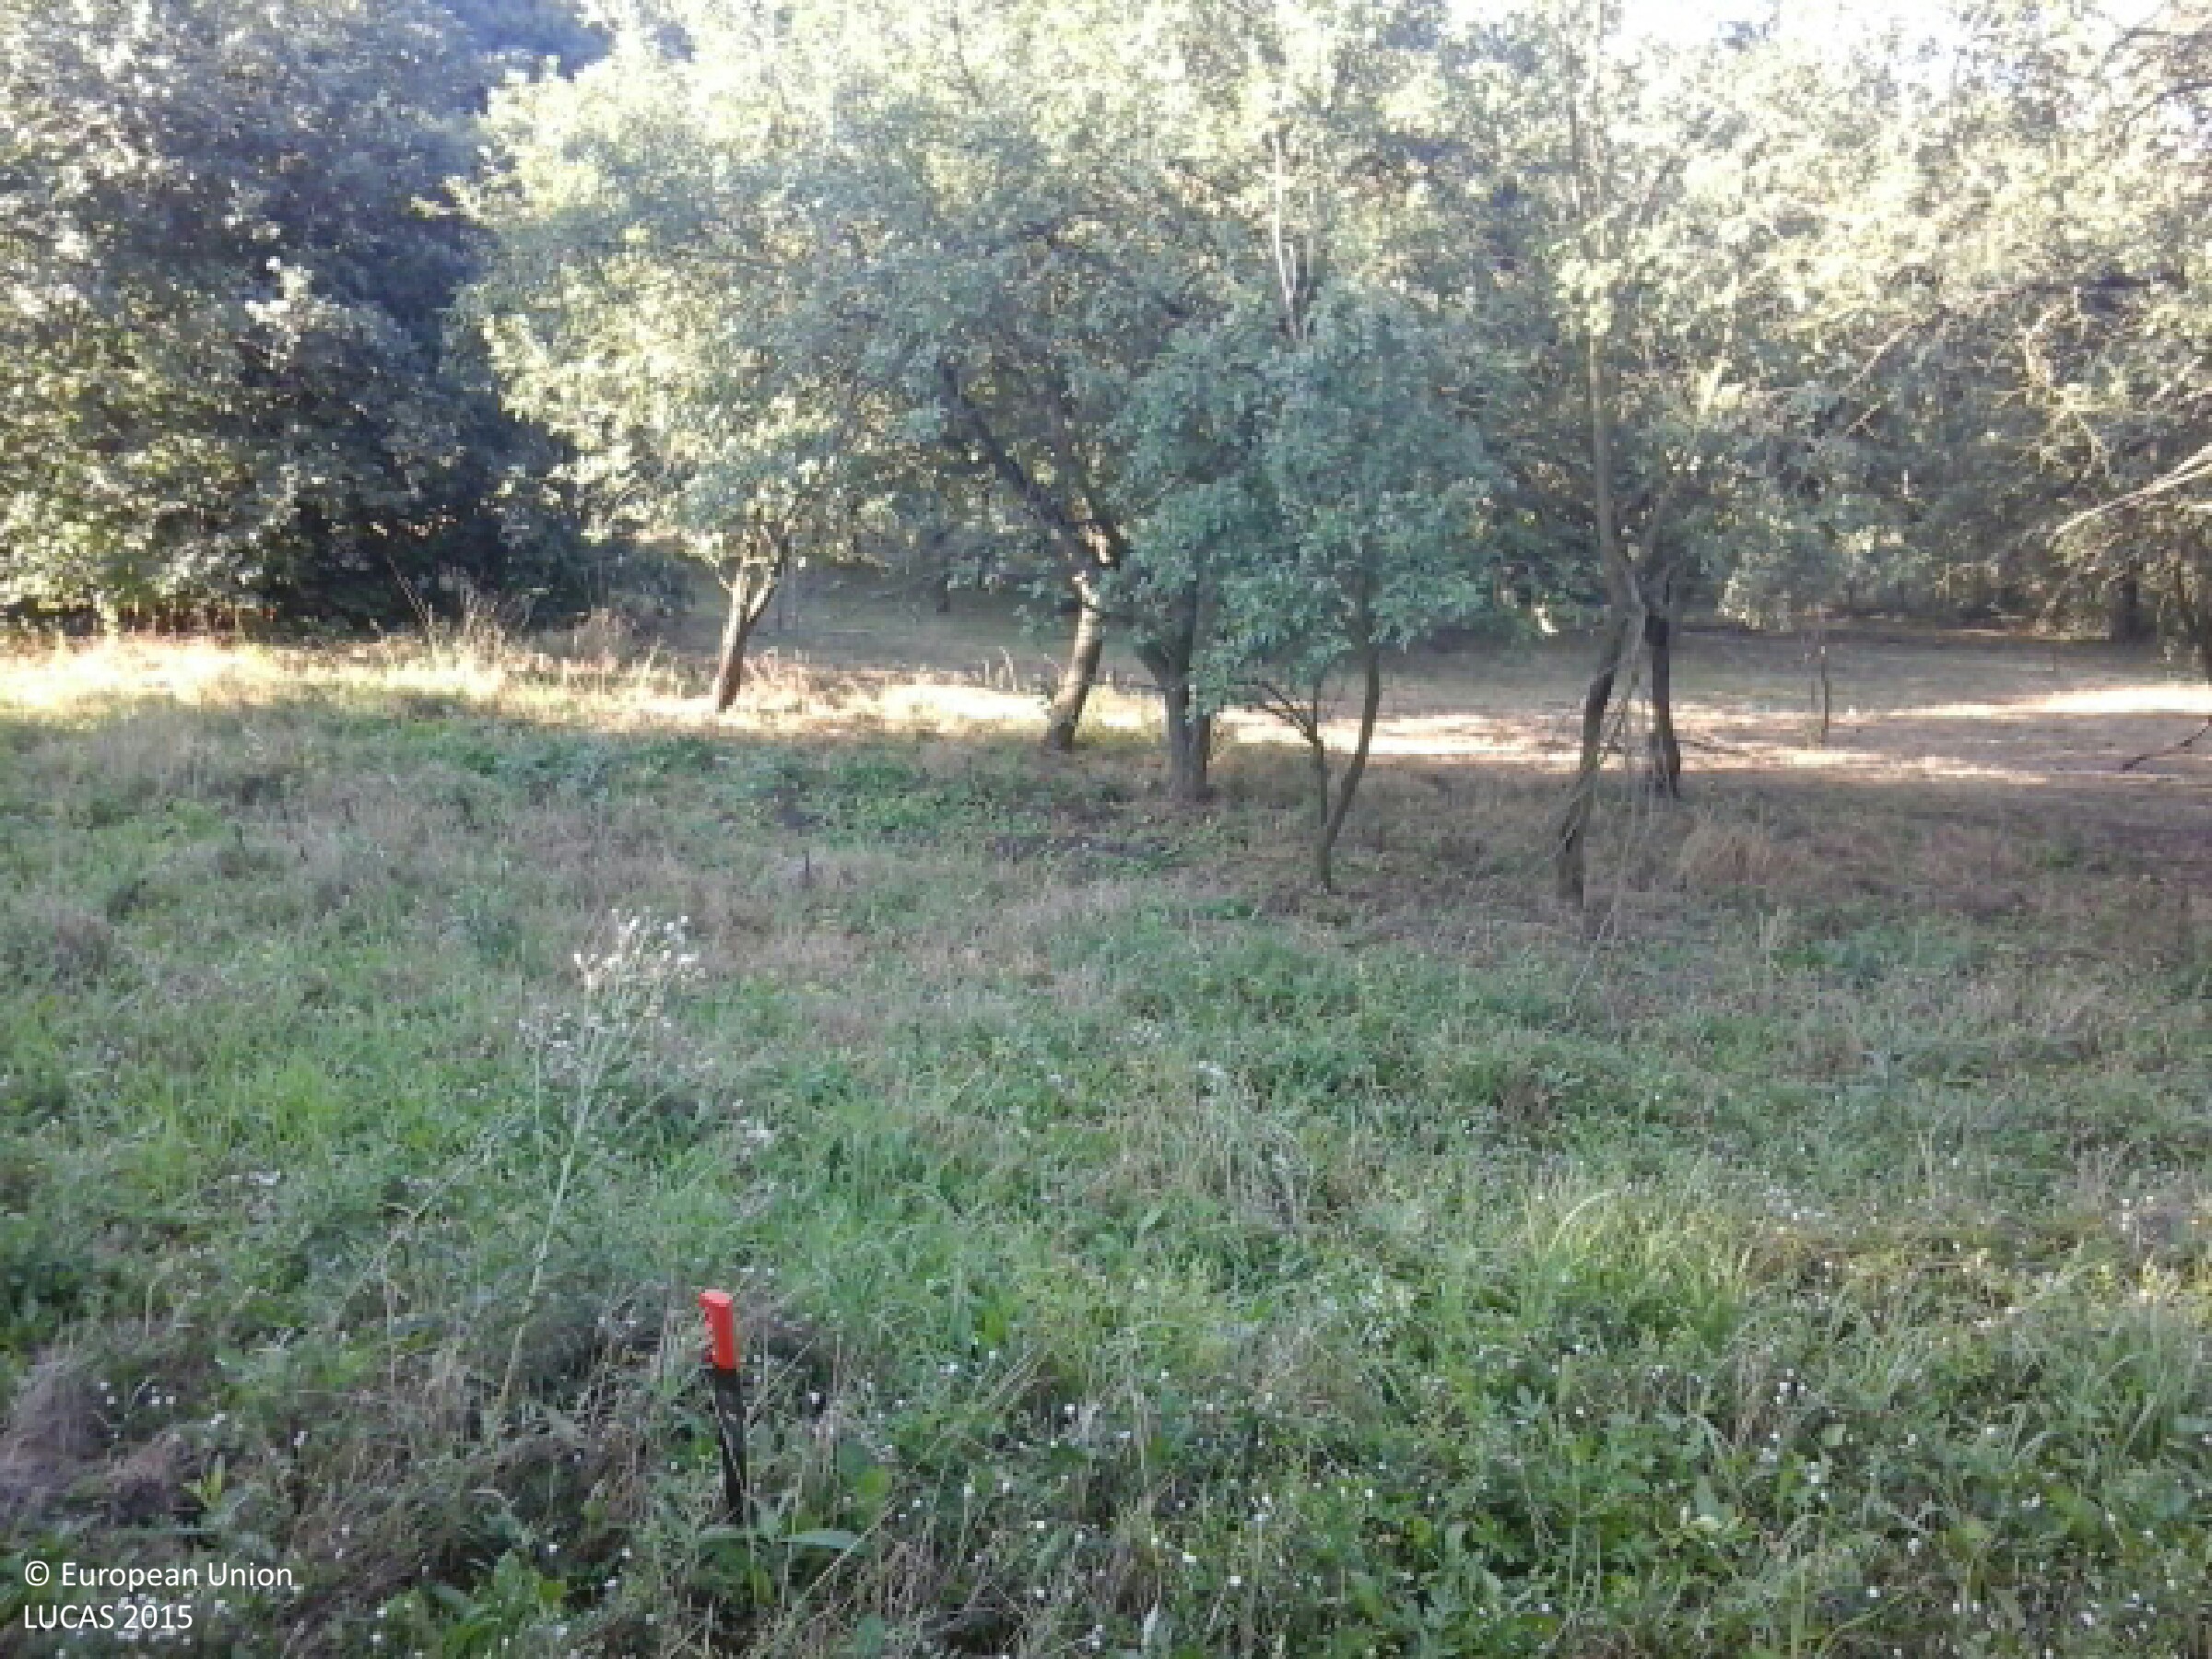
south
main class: Grassland
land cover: Grassland with sparse tree/shrub cover
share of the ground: > 75 %
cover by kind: herbaceous plants 90 %, broadleaved forest trees 5 %, shrubs 5 %
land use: Residential
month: July
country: HU
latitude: 48.2932
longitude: 21.1348
